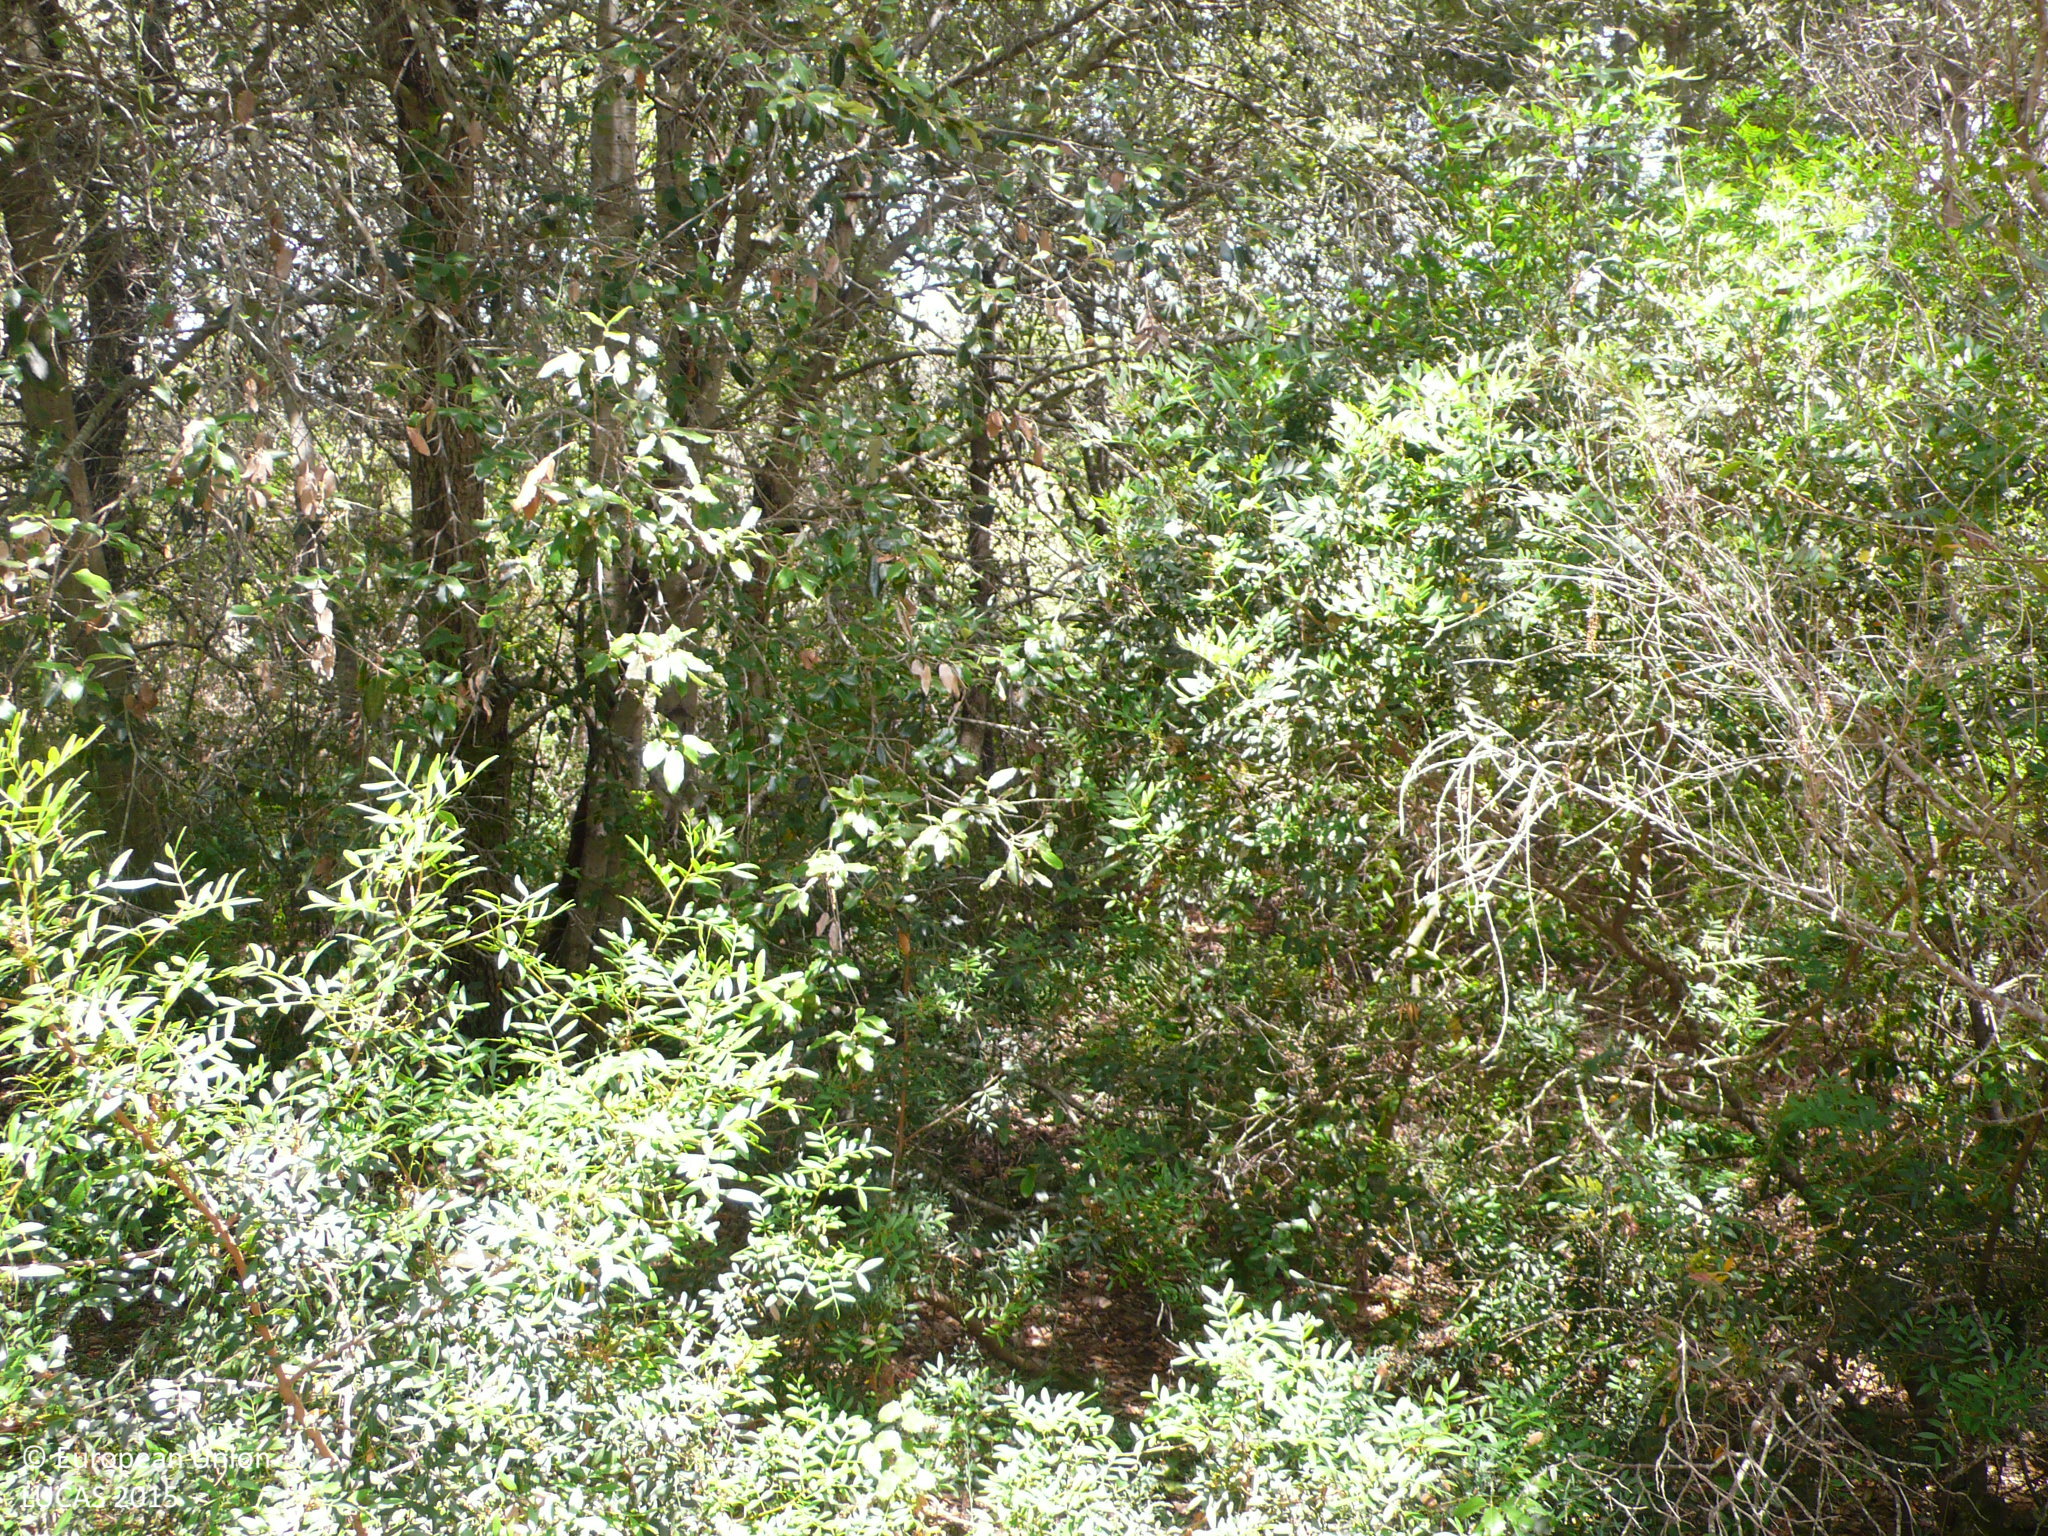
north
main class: Woodland
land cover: Pine dominated mixed woodland
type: coniferous forest of the mediterranean region
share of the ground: > 75 %
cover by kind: coniferous forest trees 55 %, broadleaved forest trees 35 %, shrubs 10 %
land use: Semi-natural and natural areas not in use
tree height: > 5 m
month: July
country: ES
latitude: 39.6586
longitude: 3.3273
